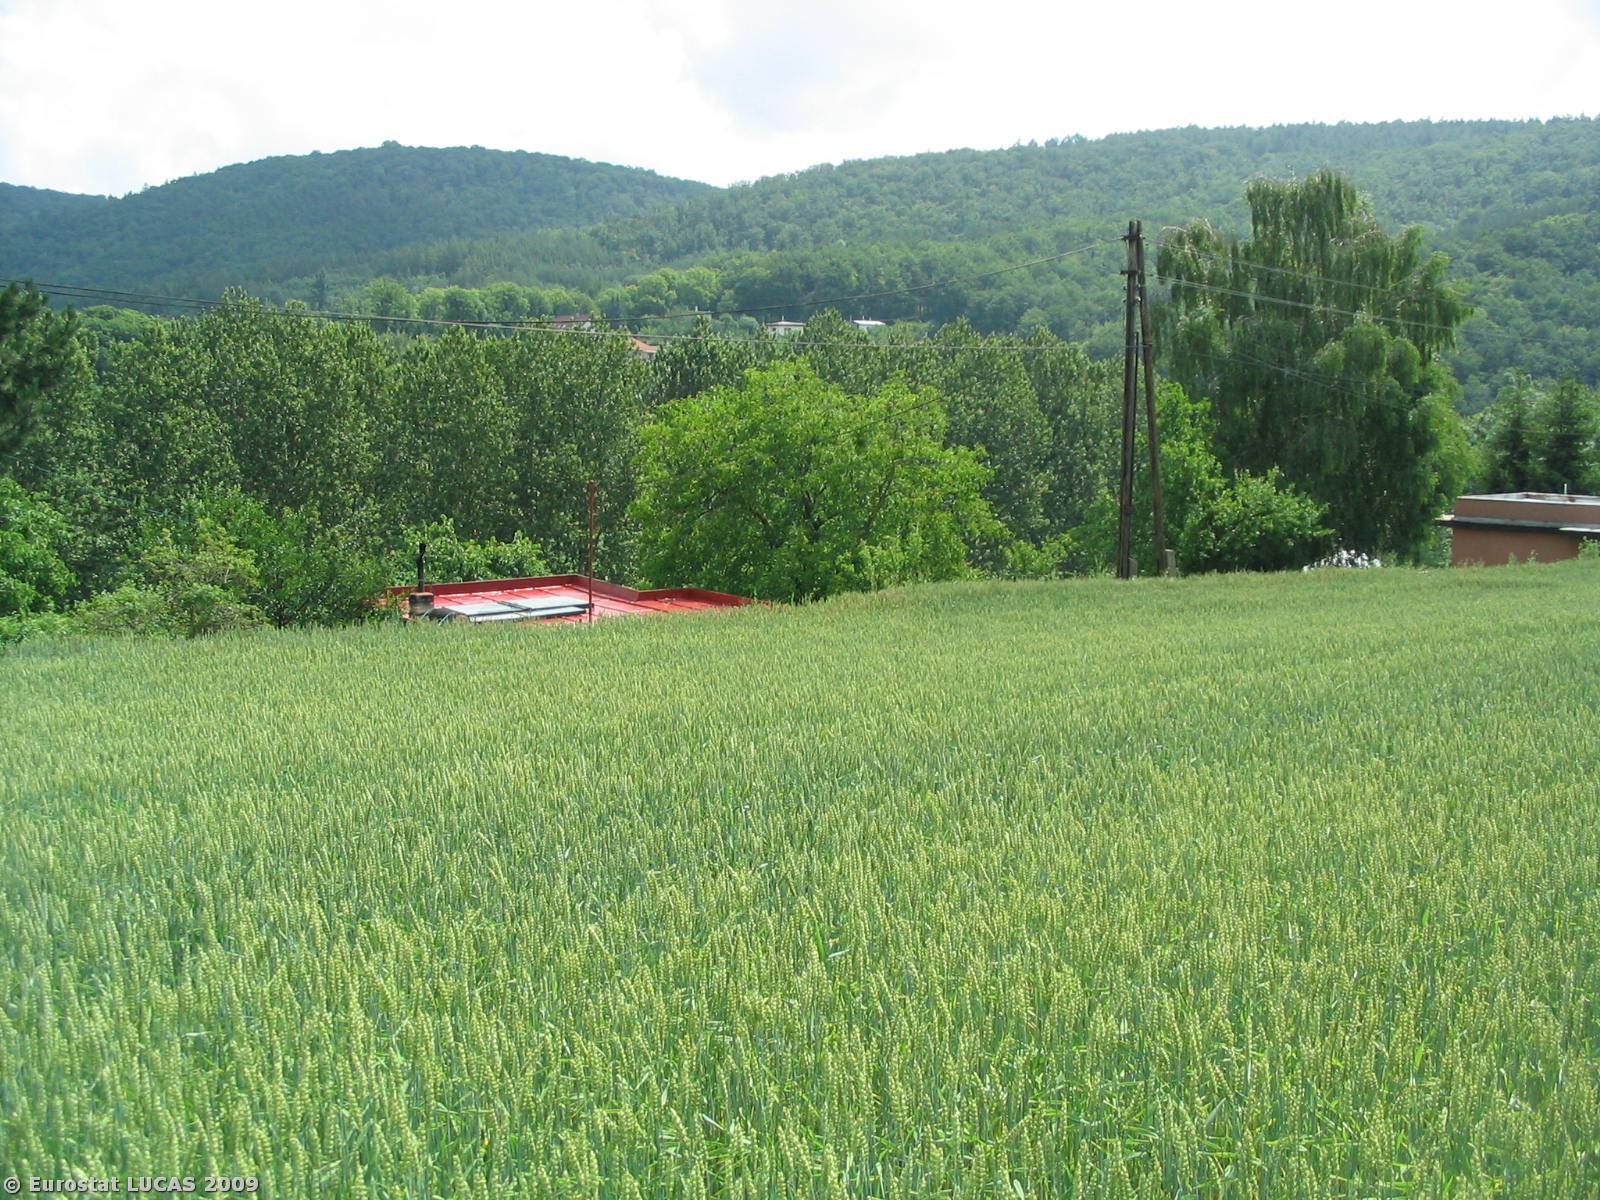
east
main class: Cropland
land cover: Common wheat
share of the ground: > 75 %
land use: Agriculture (excluding fallow land and kitchen gardens)
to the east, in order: Common wheat; Grassland without tree/shrub cover; Electric lines; Grassland without tree/shrub cover; Fences; Artificial constructions in urban areas; Paved roads, cycling and walking lanes; Other structural elements; Broadleaved woodland; Rivers and streams; Broadleaved woodland; Potatoes; Electric lines; Potatoes
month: June
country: CZ
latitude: 49.2797
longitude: 16.4538
